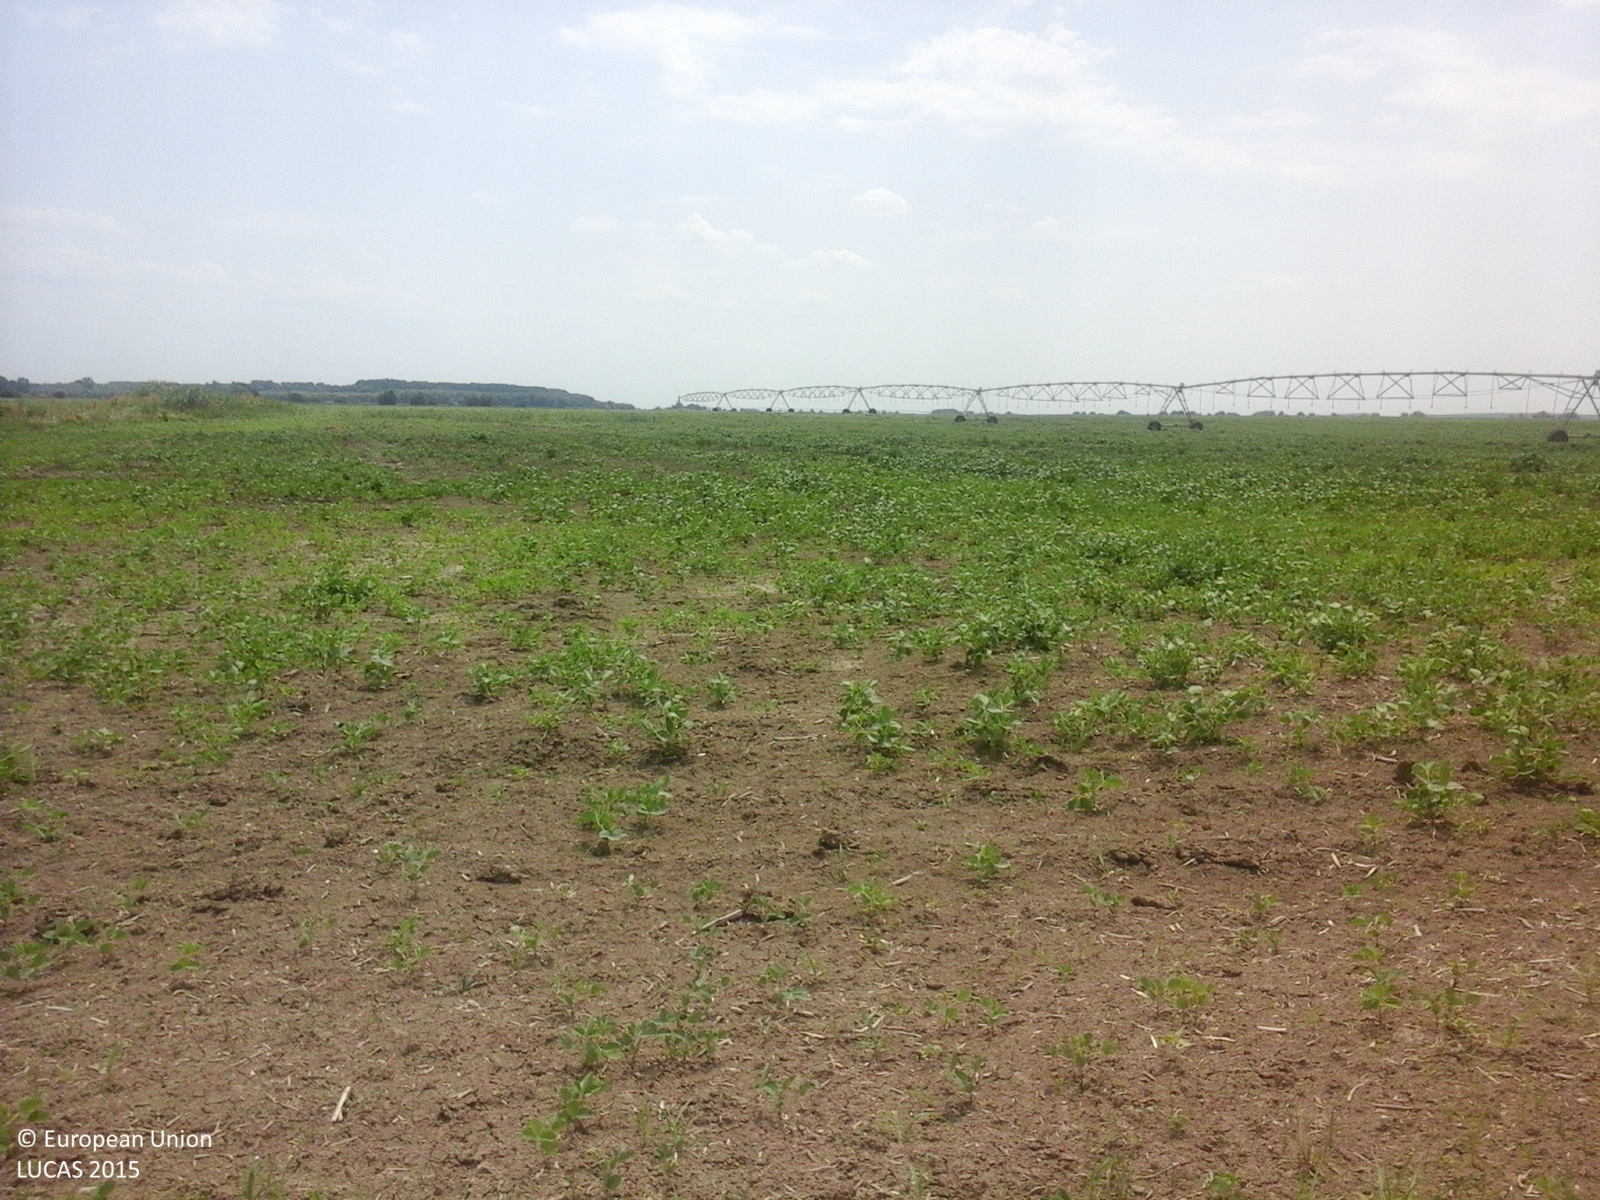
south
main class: Cropland
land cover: Soya
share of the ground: 10 - 25 %
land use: Agriculture (excluding fallow land and kitchen gardens)
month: July
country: RO
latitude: 44.5504
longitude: 27.9953
